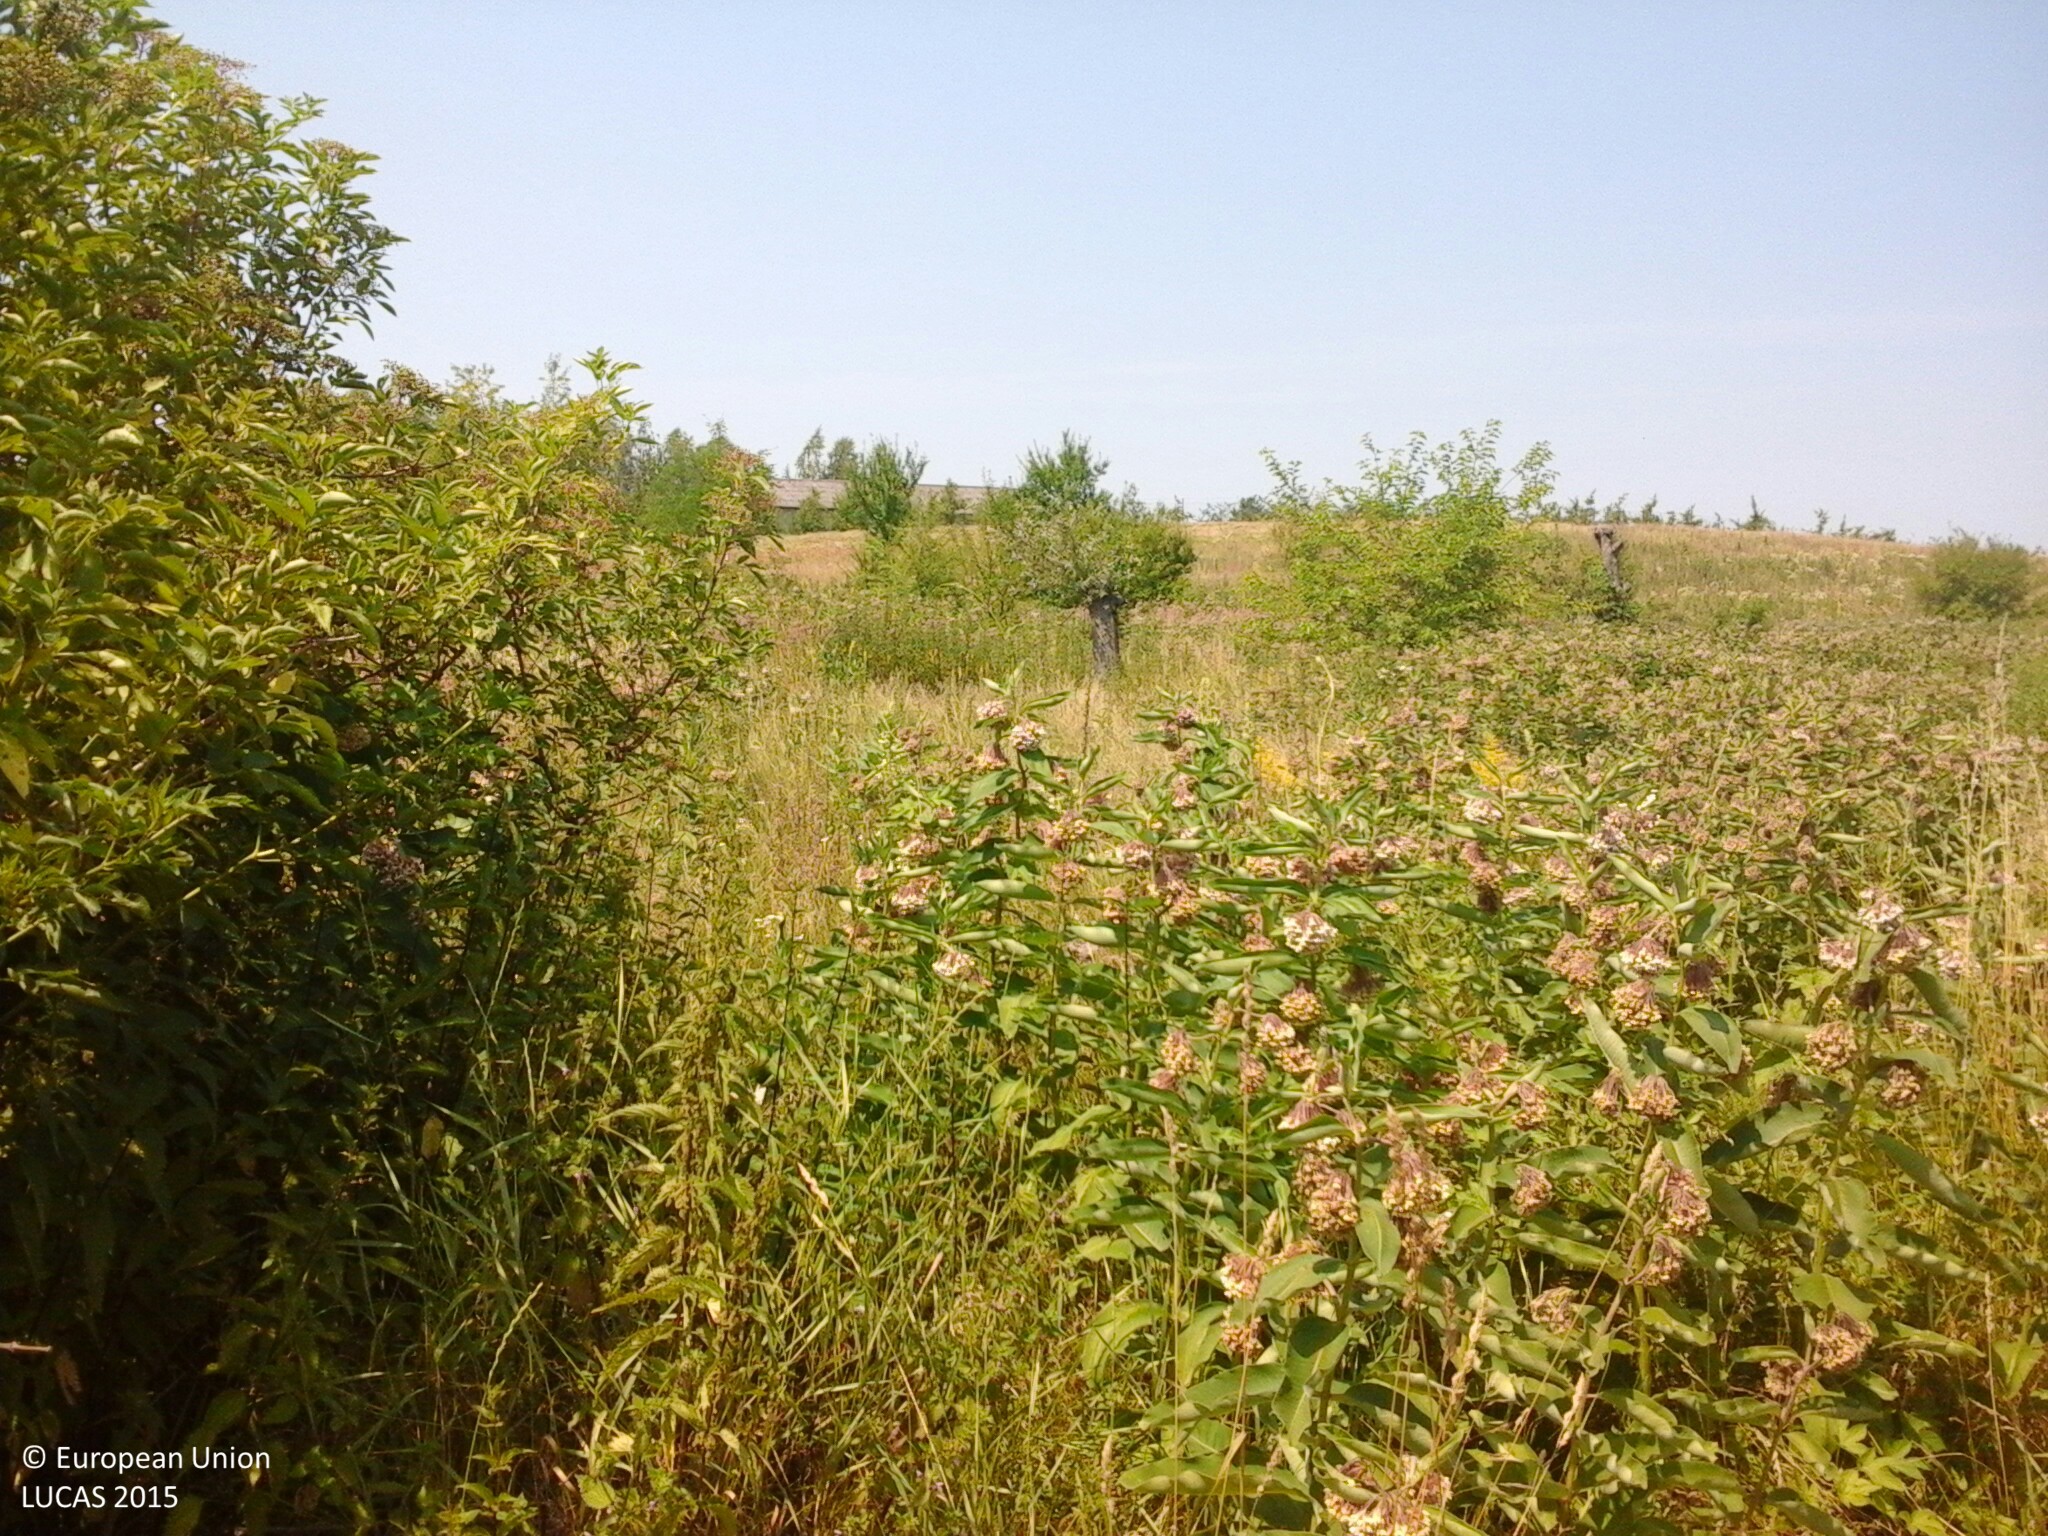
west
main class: Grassland
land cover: Grassland with sparse tree/shrub cover
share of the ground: > 75 %
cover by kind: herbaceous plants 90 %, broadleaved forest trees 5 %, shrubs 5 %
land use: Abandoned areas
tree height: < 5 m
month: July
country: HU
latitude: 48.1207
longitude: 22.2407
